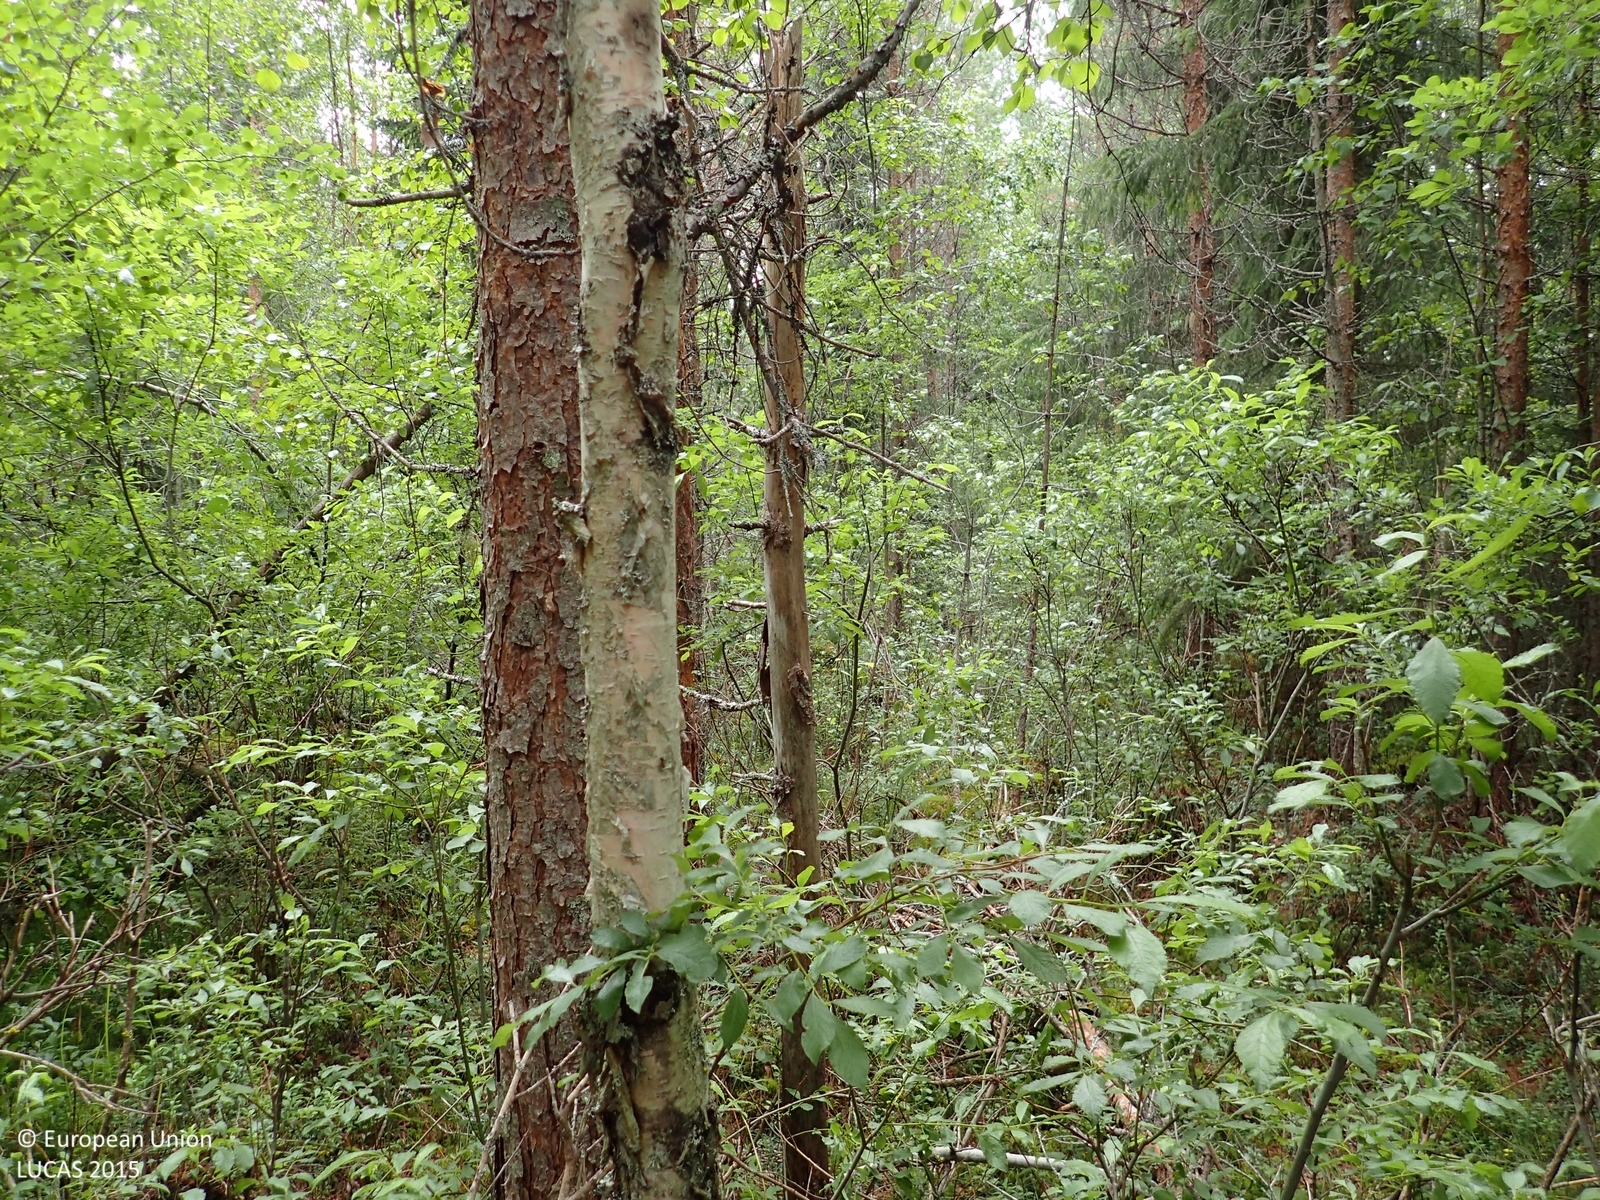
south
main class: Woodland
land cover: Pine dominated mixed woodland
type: boreal forest
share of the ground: > 75 %
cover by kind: coniferous forest trees 60 %, broadleaved forest trees 25 %, shrubs 10 %, lichens and mosses 5 %
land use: Forestry
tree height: > 5 m
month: July
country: FI
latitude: 62.8553
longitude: 22.5287
